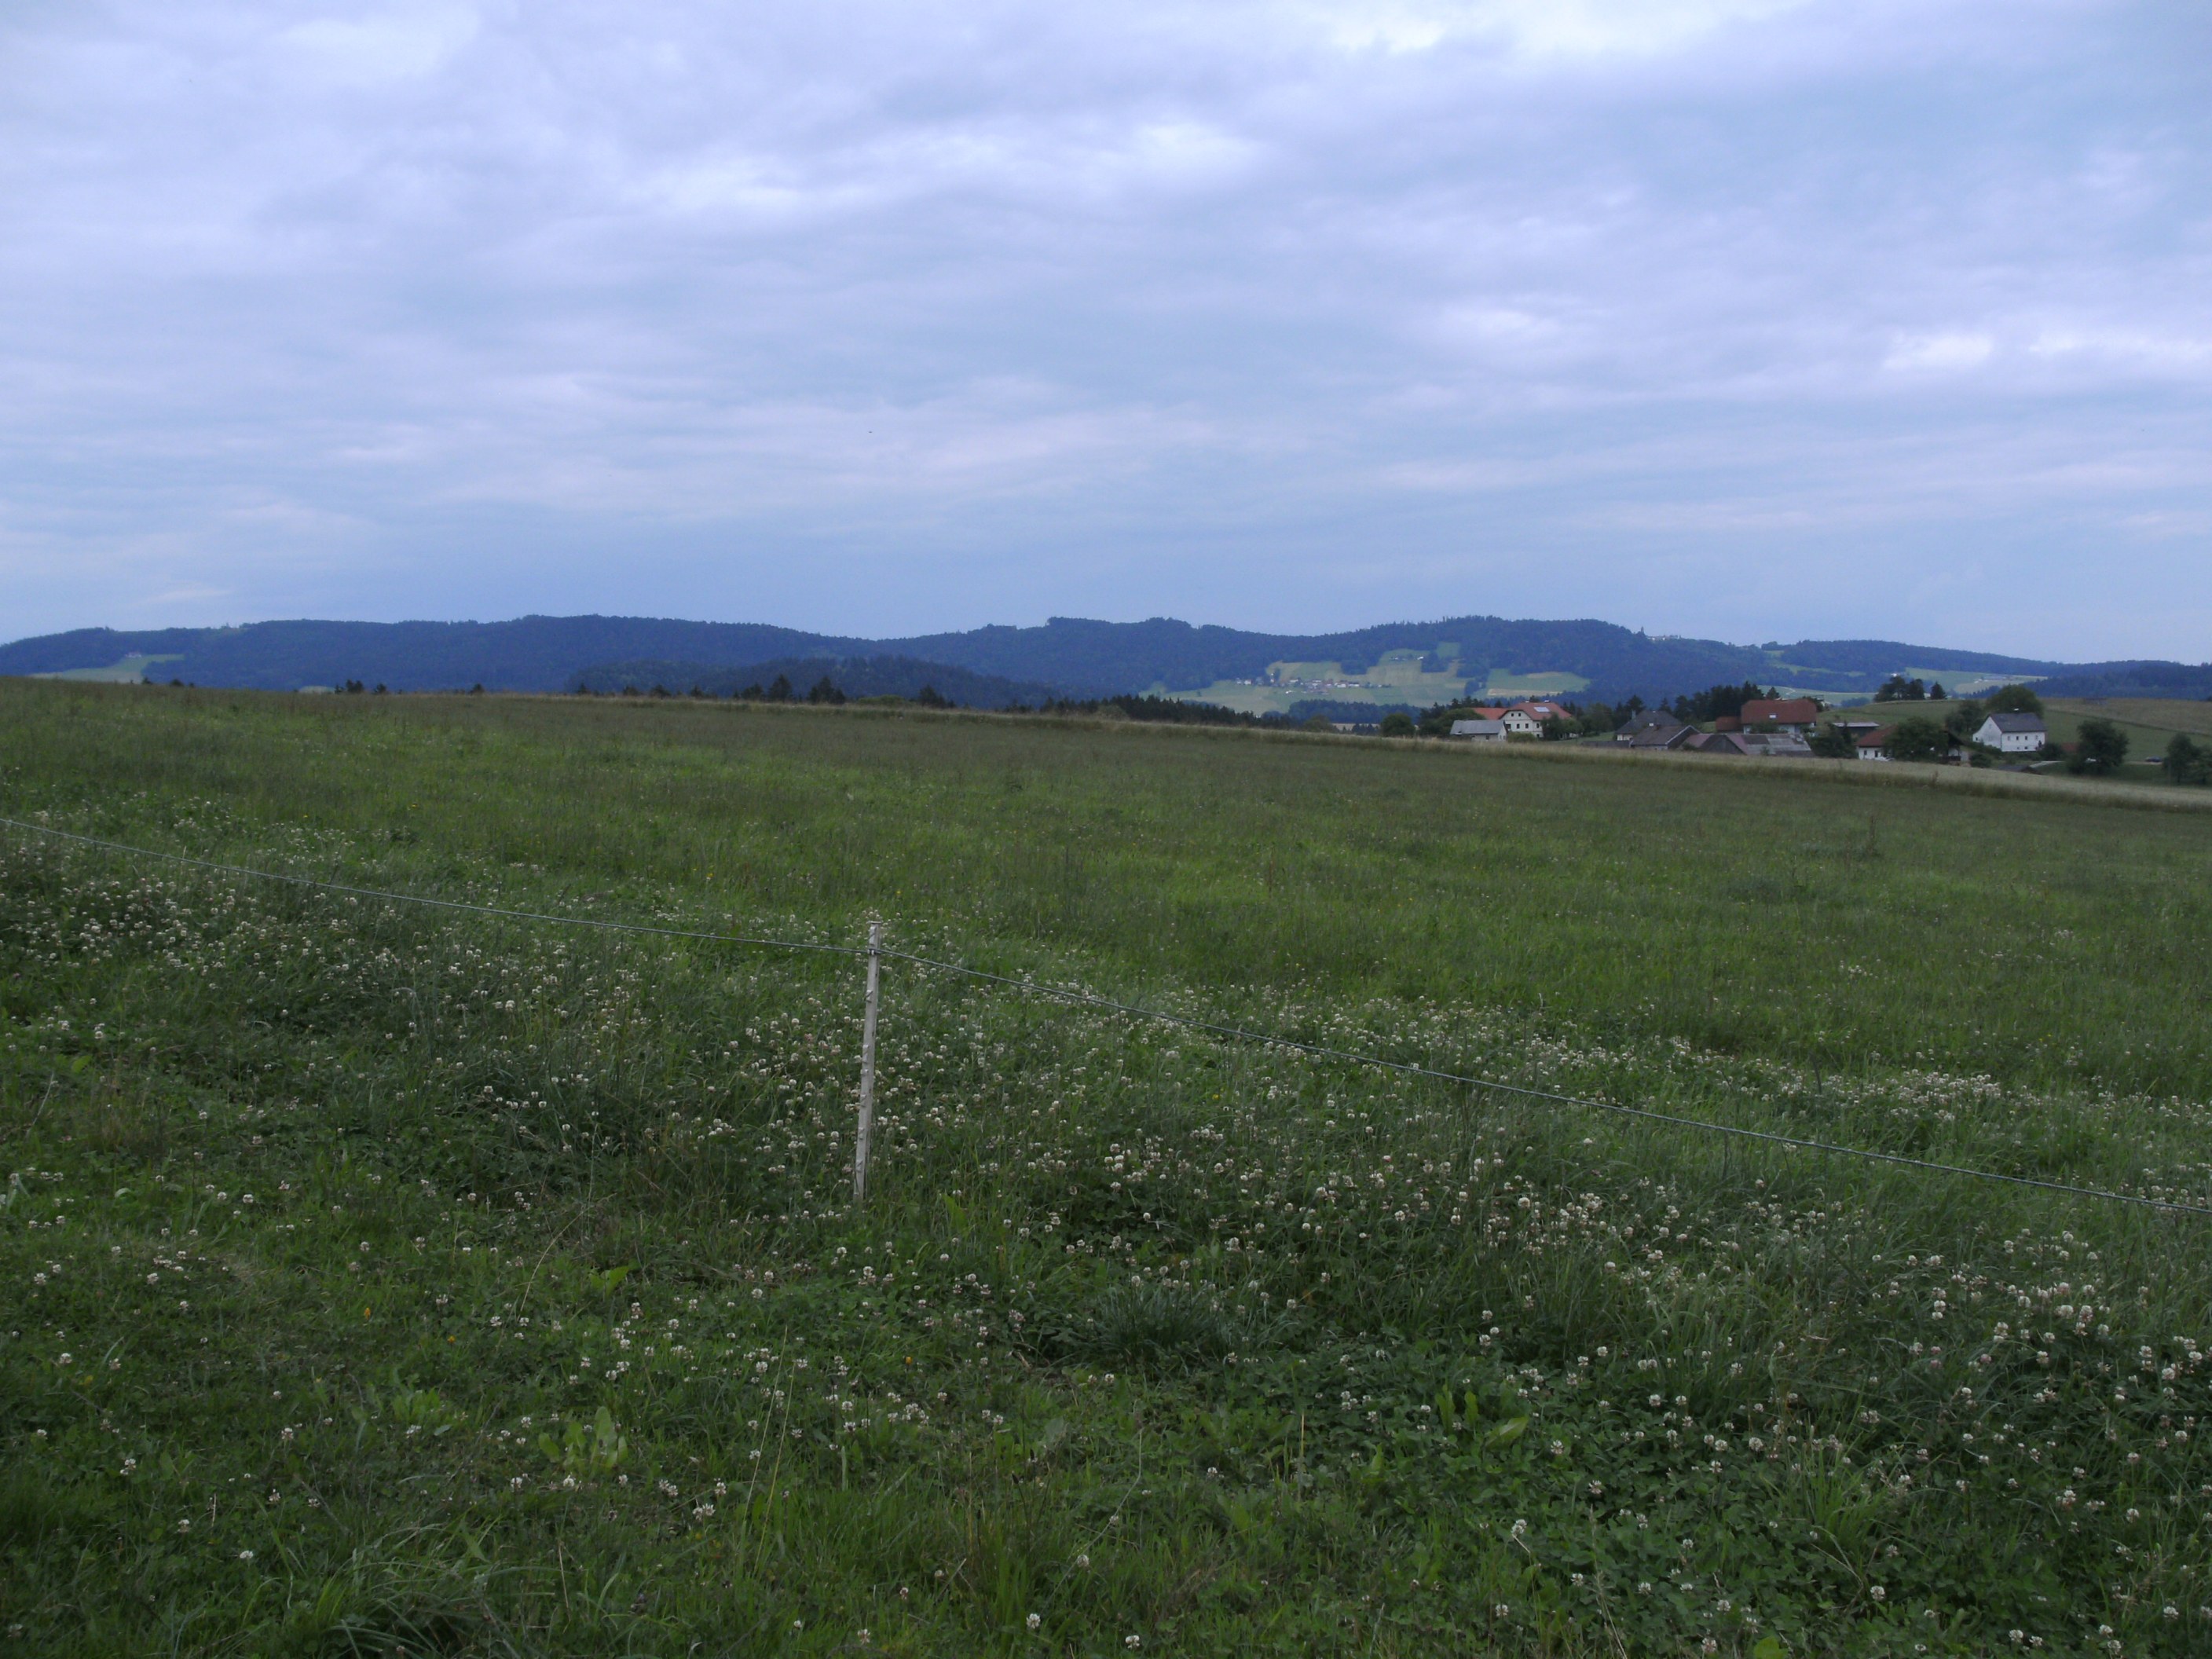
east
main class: Grassland
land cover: Grassland without tree/shrub cover
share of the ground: > 75 %
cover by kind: herbaceous plants 100 %
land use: Agriculture (excluding fallow land and kitchen gardens)
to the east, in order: Grassland without tree/shrub cover; Fences; Temporary grasslands; Tracks; Grass margins; Common wheat; Grass margins; Tracks; Temporary grasslands
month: June
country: AT
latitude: 48.5200
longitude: 13.7501
